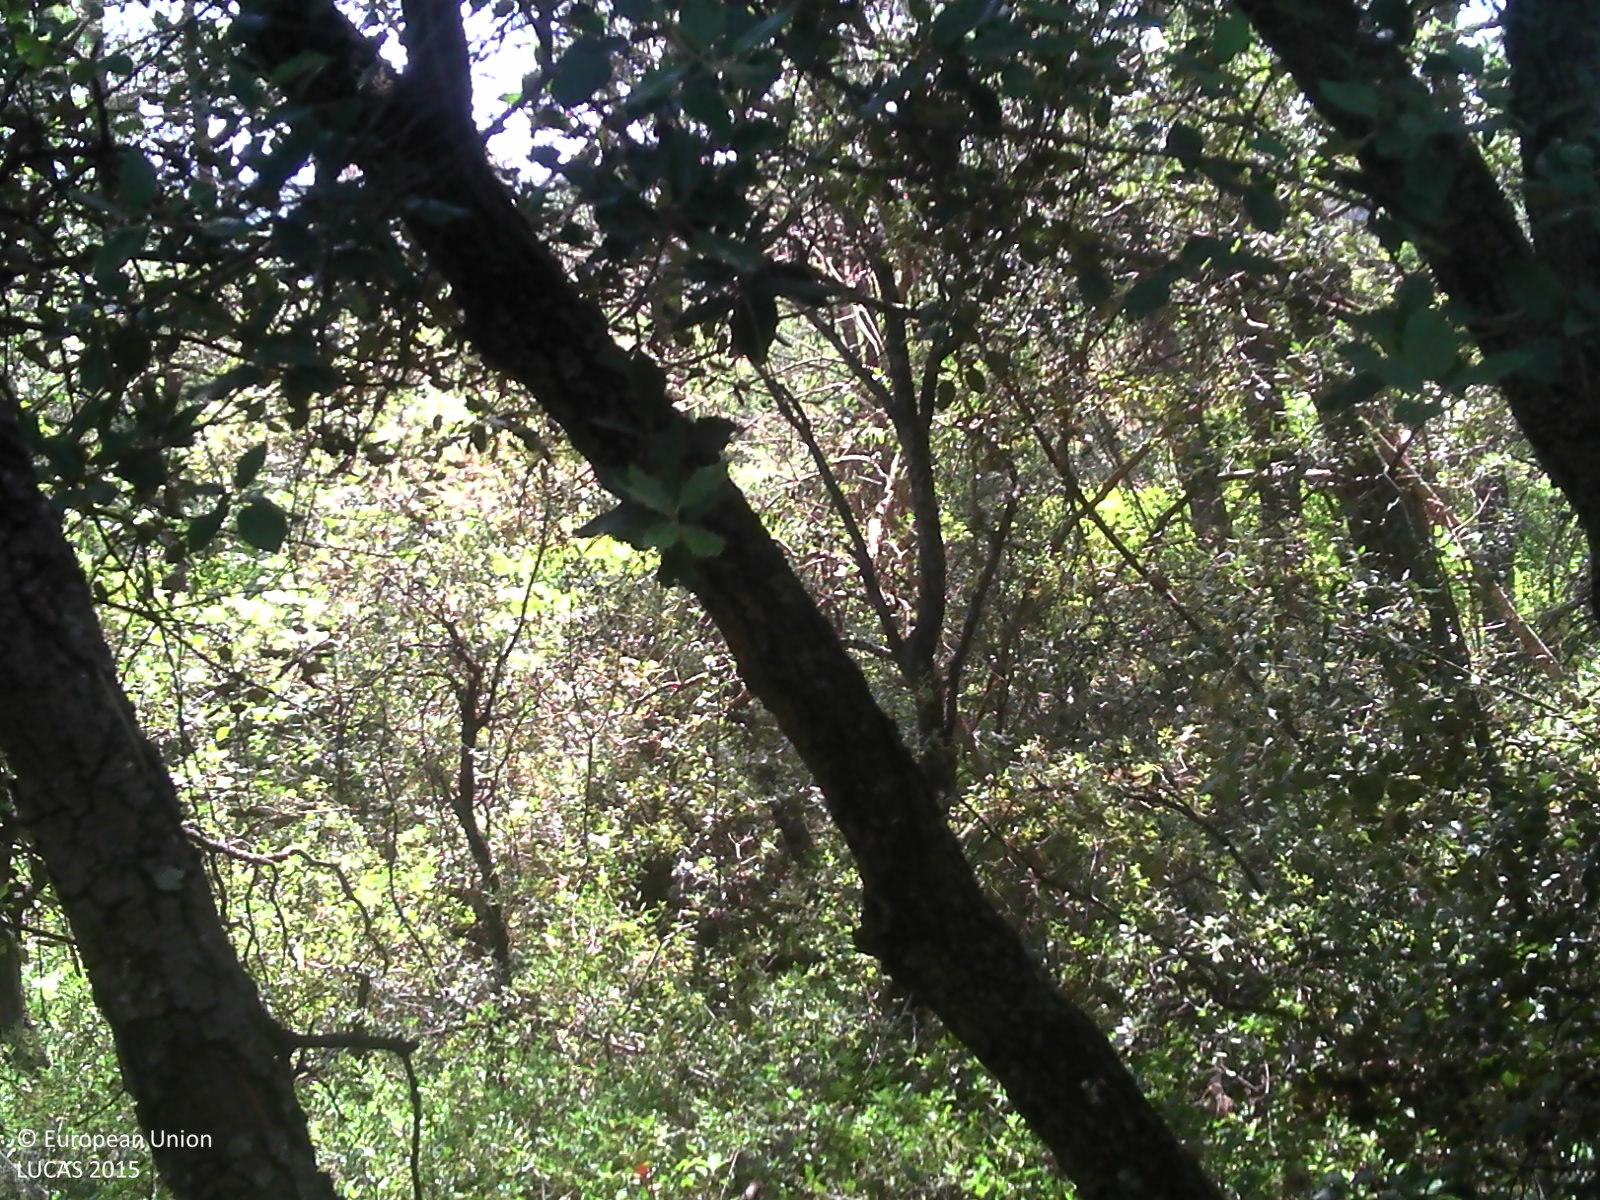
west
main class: Woodland
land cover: Pine dominated mixed woodland
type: coniferous forest of the mediterranean region
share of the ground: > 75 %
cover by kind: coniferous forest trees 45 %, broadleaved forest trees 40 %, herbaceous plants 10 %, shrubs 5 %
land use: Forestry
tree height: > 5 m
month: July
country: FR
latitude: 43.6663
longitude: 5.3091
